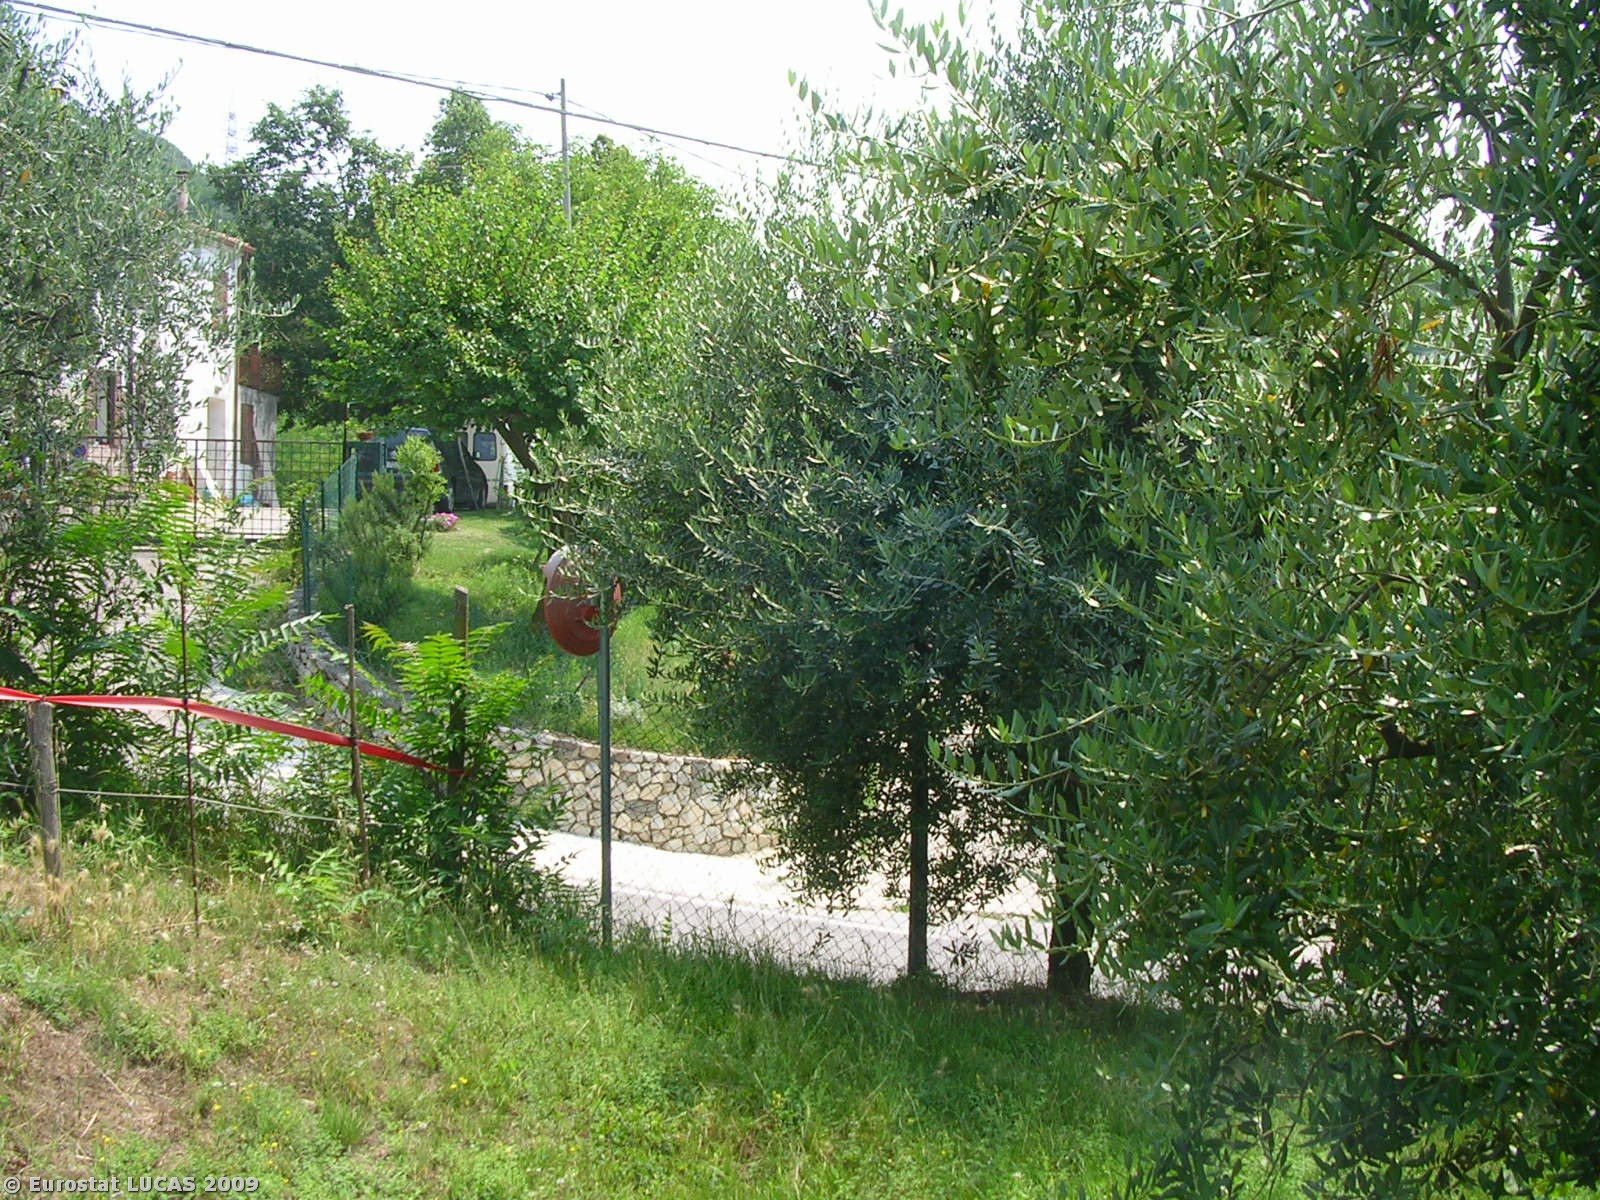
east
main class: Cropland
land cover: Olive groves
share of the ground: 50 - 75 %
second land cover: Grassland with sparse tree/shrub cover
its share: 50 - 75 %
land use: Agriculture (excluding fallow land and kitchen gardens)
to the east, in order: Olive groves; Grassland with sparse tree/shrub cover; Fences; Managed hedges; Grass margins; Paved roads, cycling and walking lanes; Fences; Single bushes/trees; Artificial constructions in urban areas; Broadleaved woodland; Olive groves; Grassland with sparse tree/shrub cover; Grassland without tree/shrub cover; Single bushes/trees; Paved roads, cycling and walking lanes; Broadleaved woodland
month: July
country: IT
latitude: 45.2389
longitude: 11.6659
